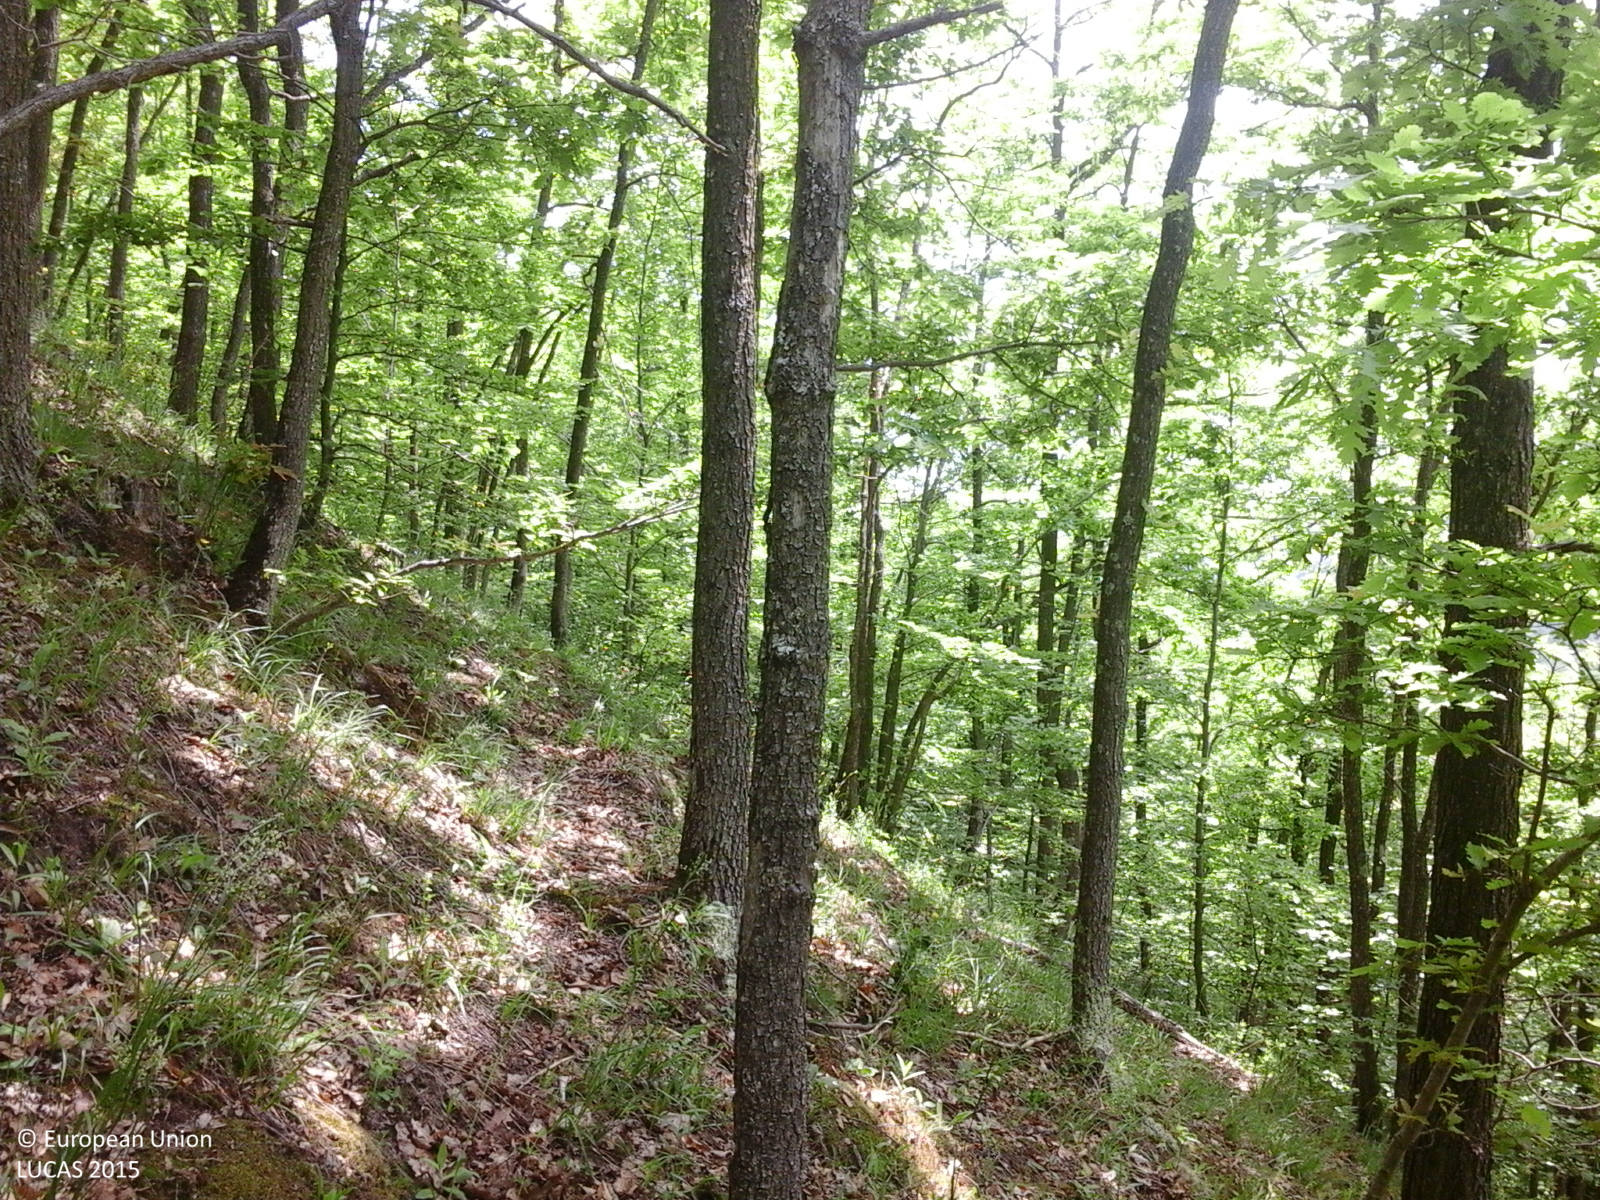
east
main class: Woodland
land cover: Broadleaved woodland
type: acidophilous oak and oak-birch forest
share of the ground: > 75 %
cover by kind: broadleaved forest trees 100 %
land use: Forestry
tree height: > 5 m
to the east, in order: Broadleaved woodland
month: May
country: RO
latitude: 45.7617
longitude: 25.9937
